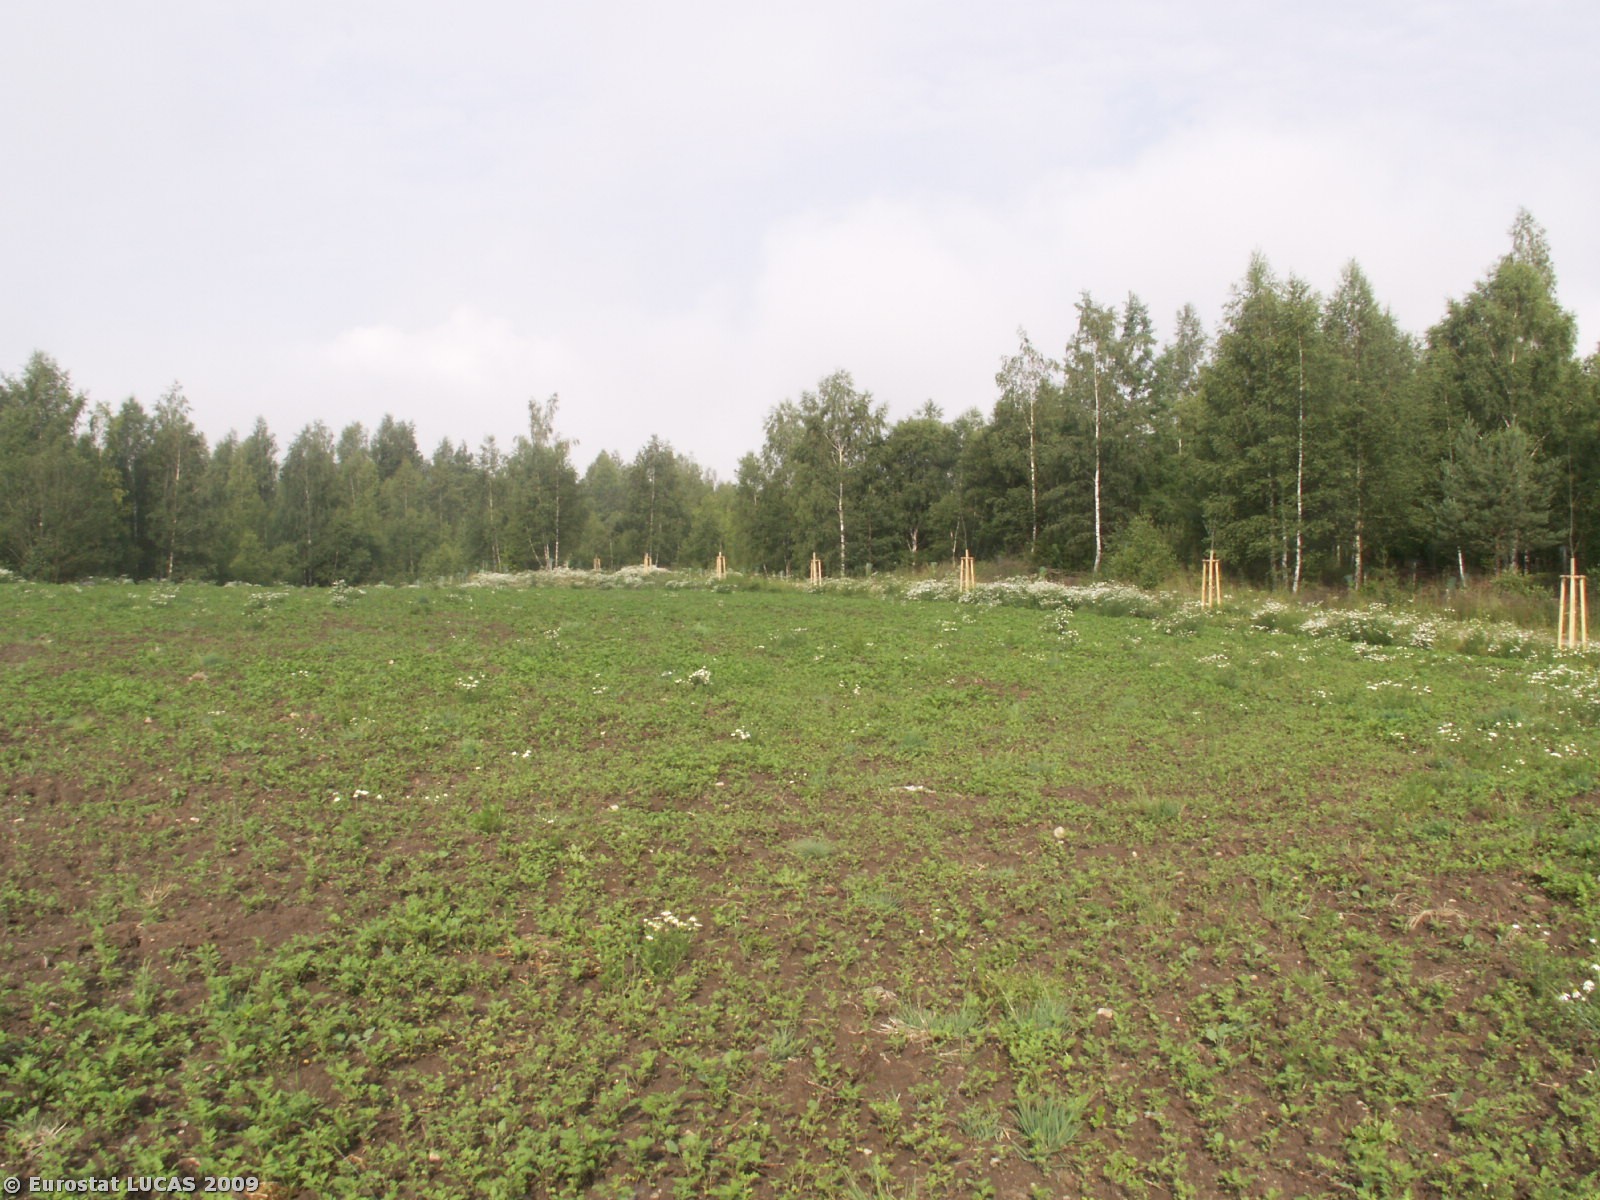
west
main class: Cropland
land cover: Other fibre and oleaginous crops
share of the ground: > 75 %
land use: Agriculture (excluding fallow land and kitchen gardens)
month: July
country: CZ
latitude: 50.1536
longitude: 12.6450
